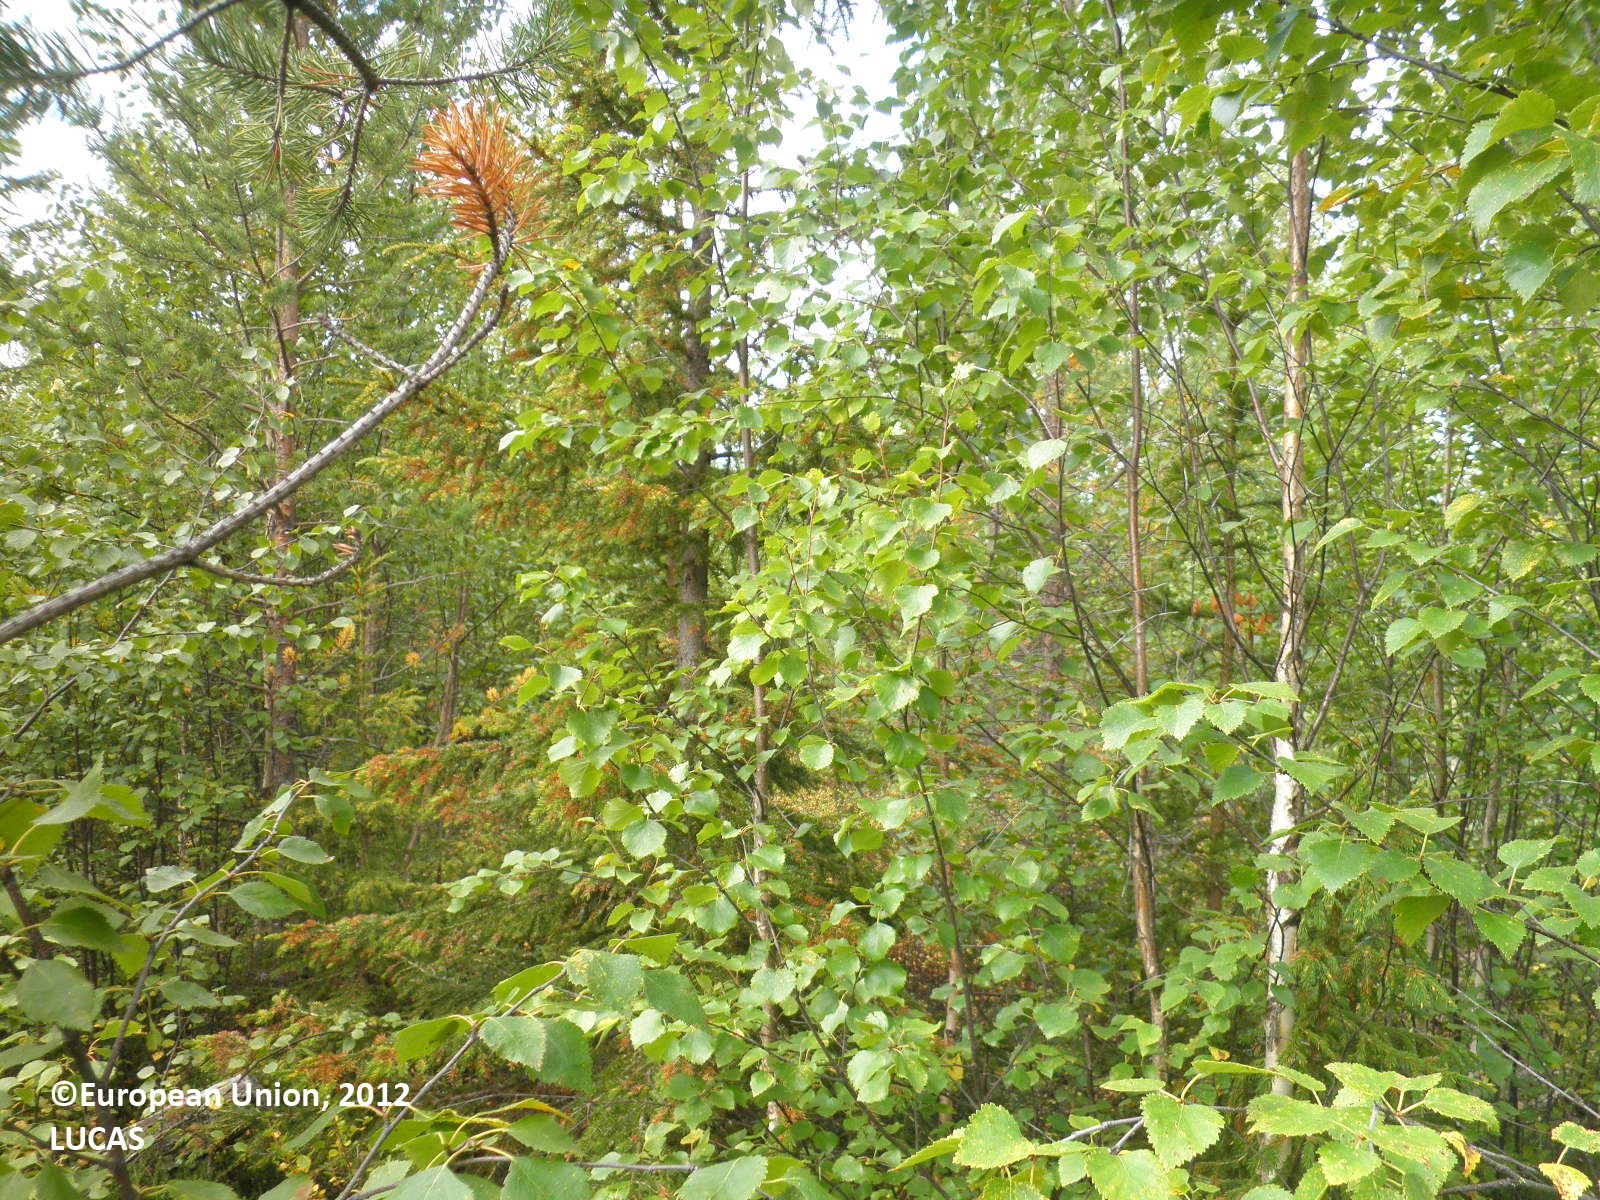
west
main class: Woodland
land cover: Pine dominated mixed woodland
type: boreal forest
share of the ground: 50 - 75 %
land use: Forestry
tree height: > 5 m
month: August
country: FI
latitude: 67.5387
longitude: 27.0903
